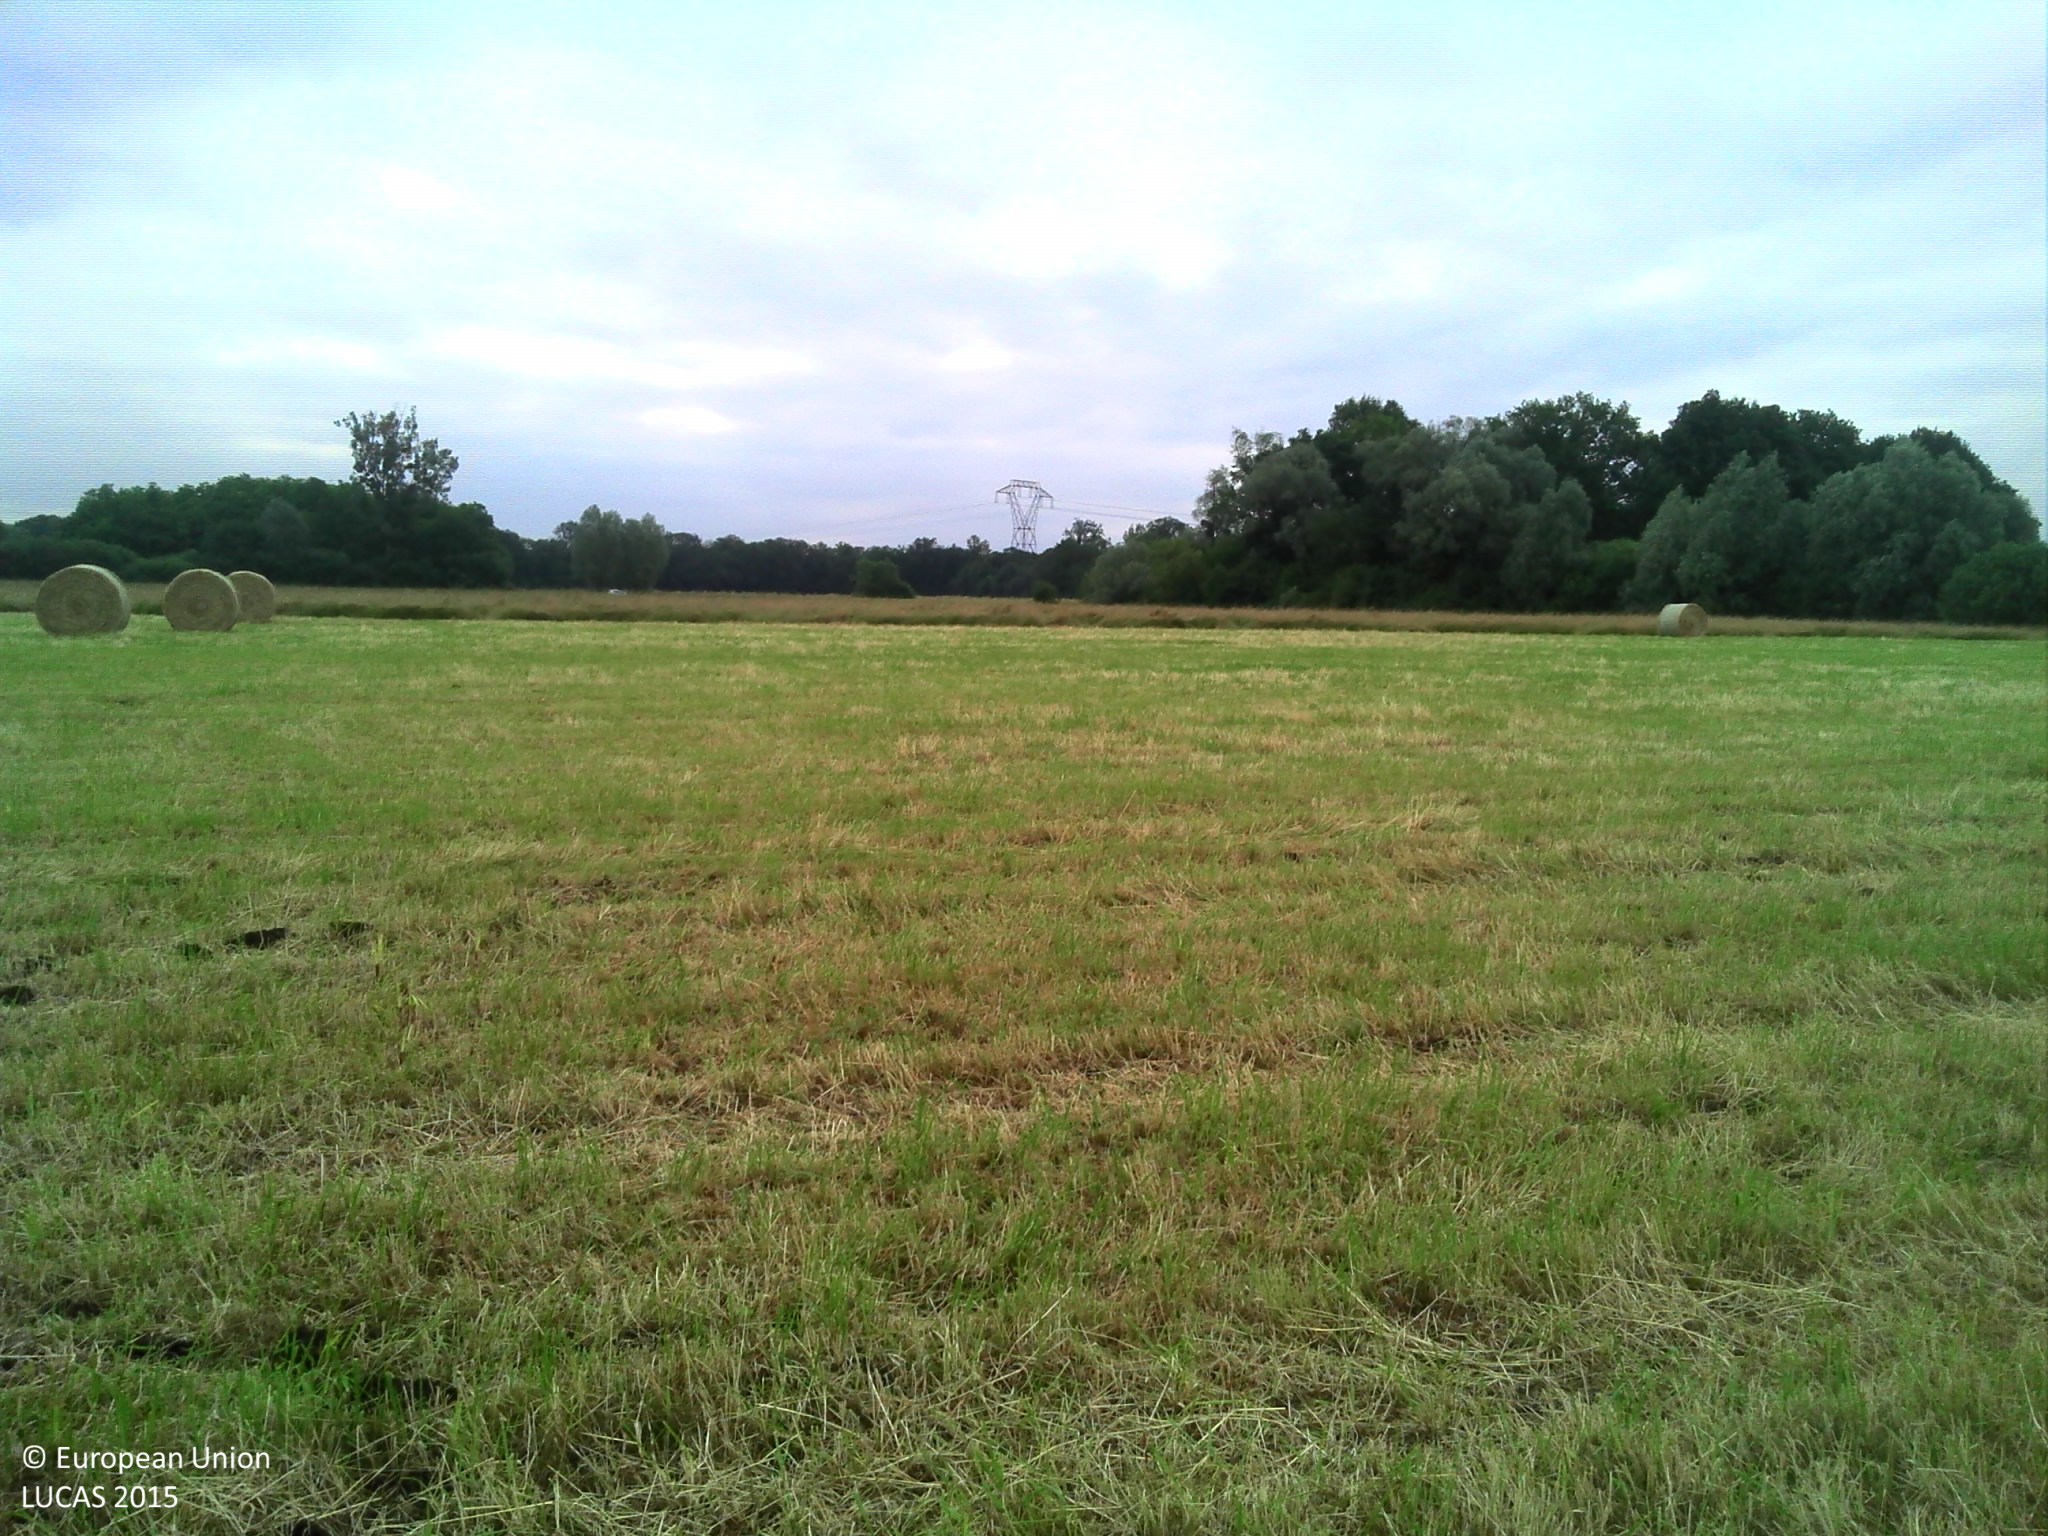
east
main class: Grassland
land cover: Grassland without tree/shrub cover
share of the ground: > 75 %
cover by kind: herbaceous plants 100 %
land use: Agriculture (excluding fallow land and kitchen gardens)
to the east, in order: Grassland without tree/shrub cover
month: June
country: FR
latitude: 48.4856
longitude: 7.6061
